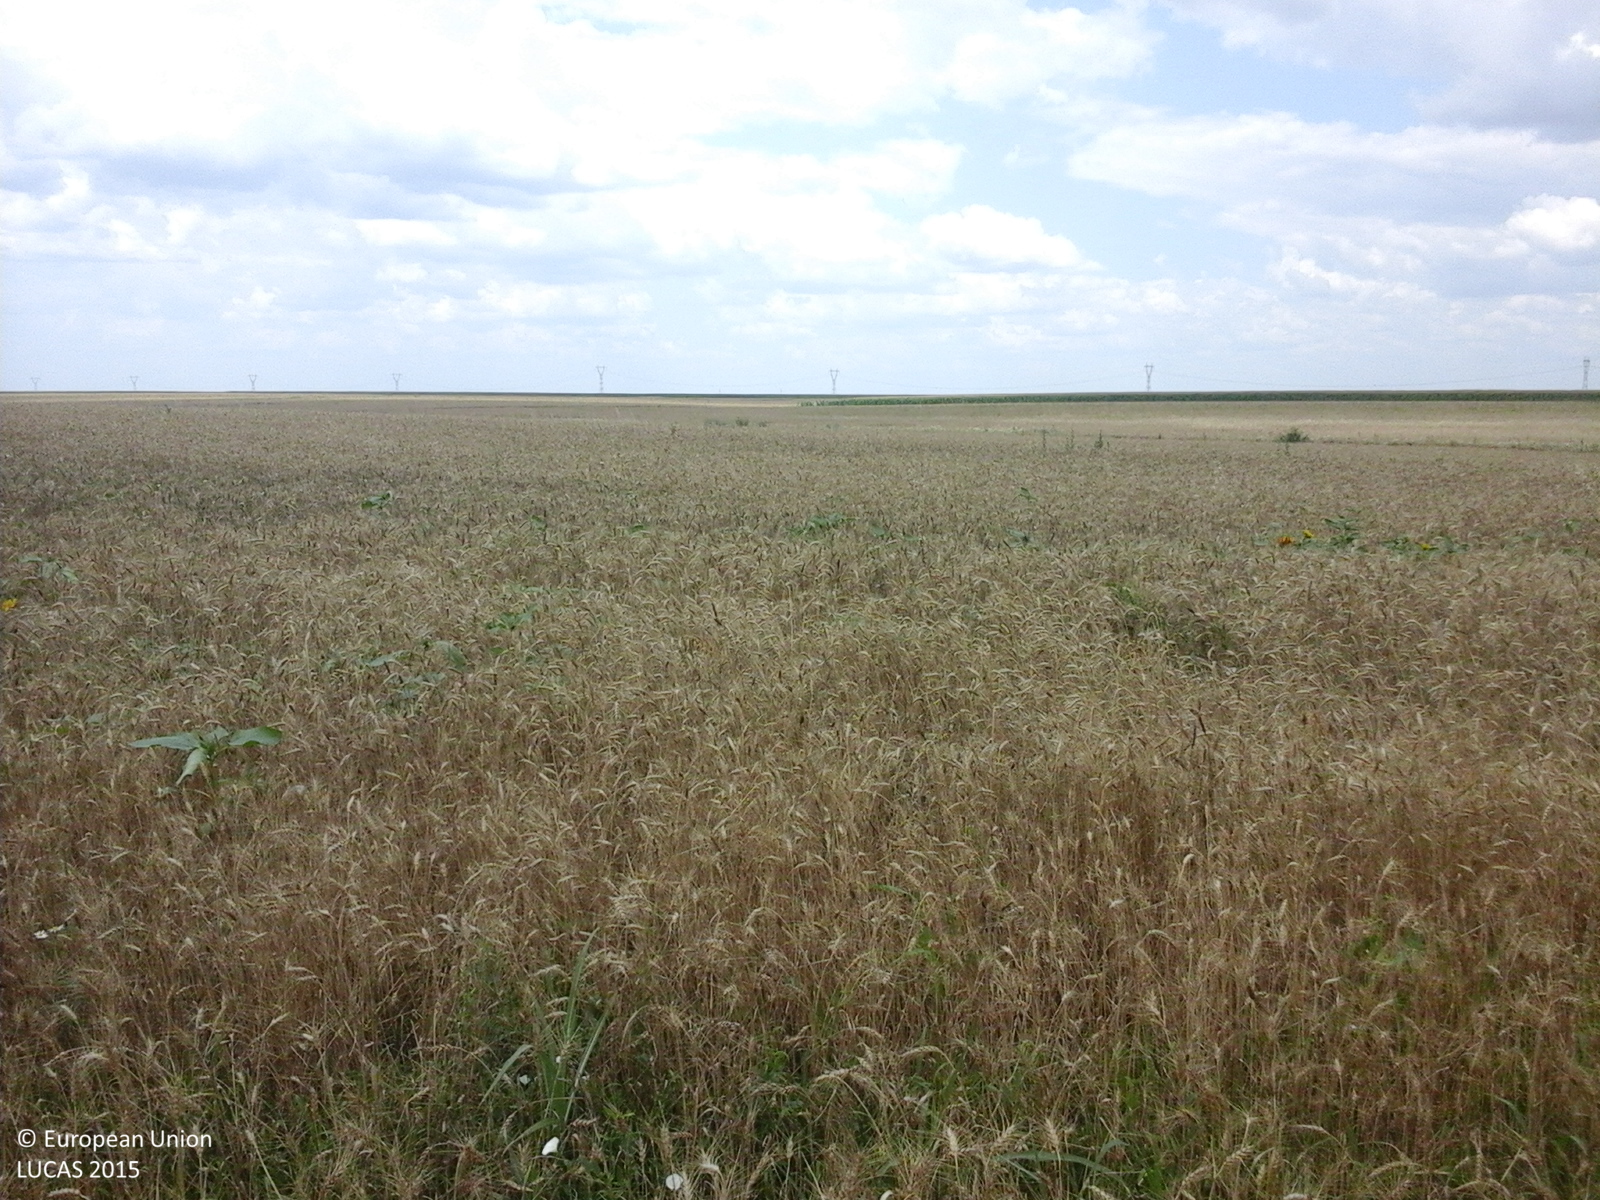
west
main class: Cropland
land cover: Common wheat
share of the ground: > 75 %
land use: Agriculture (excluding fallow land and kitchen gardens)
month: July
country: RO
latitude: 43.8613
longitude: 25.2213
